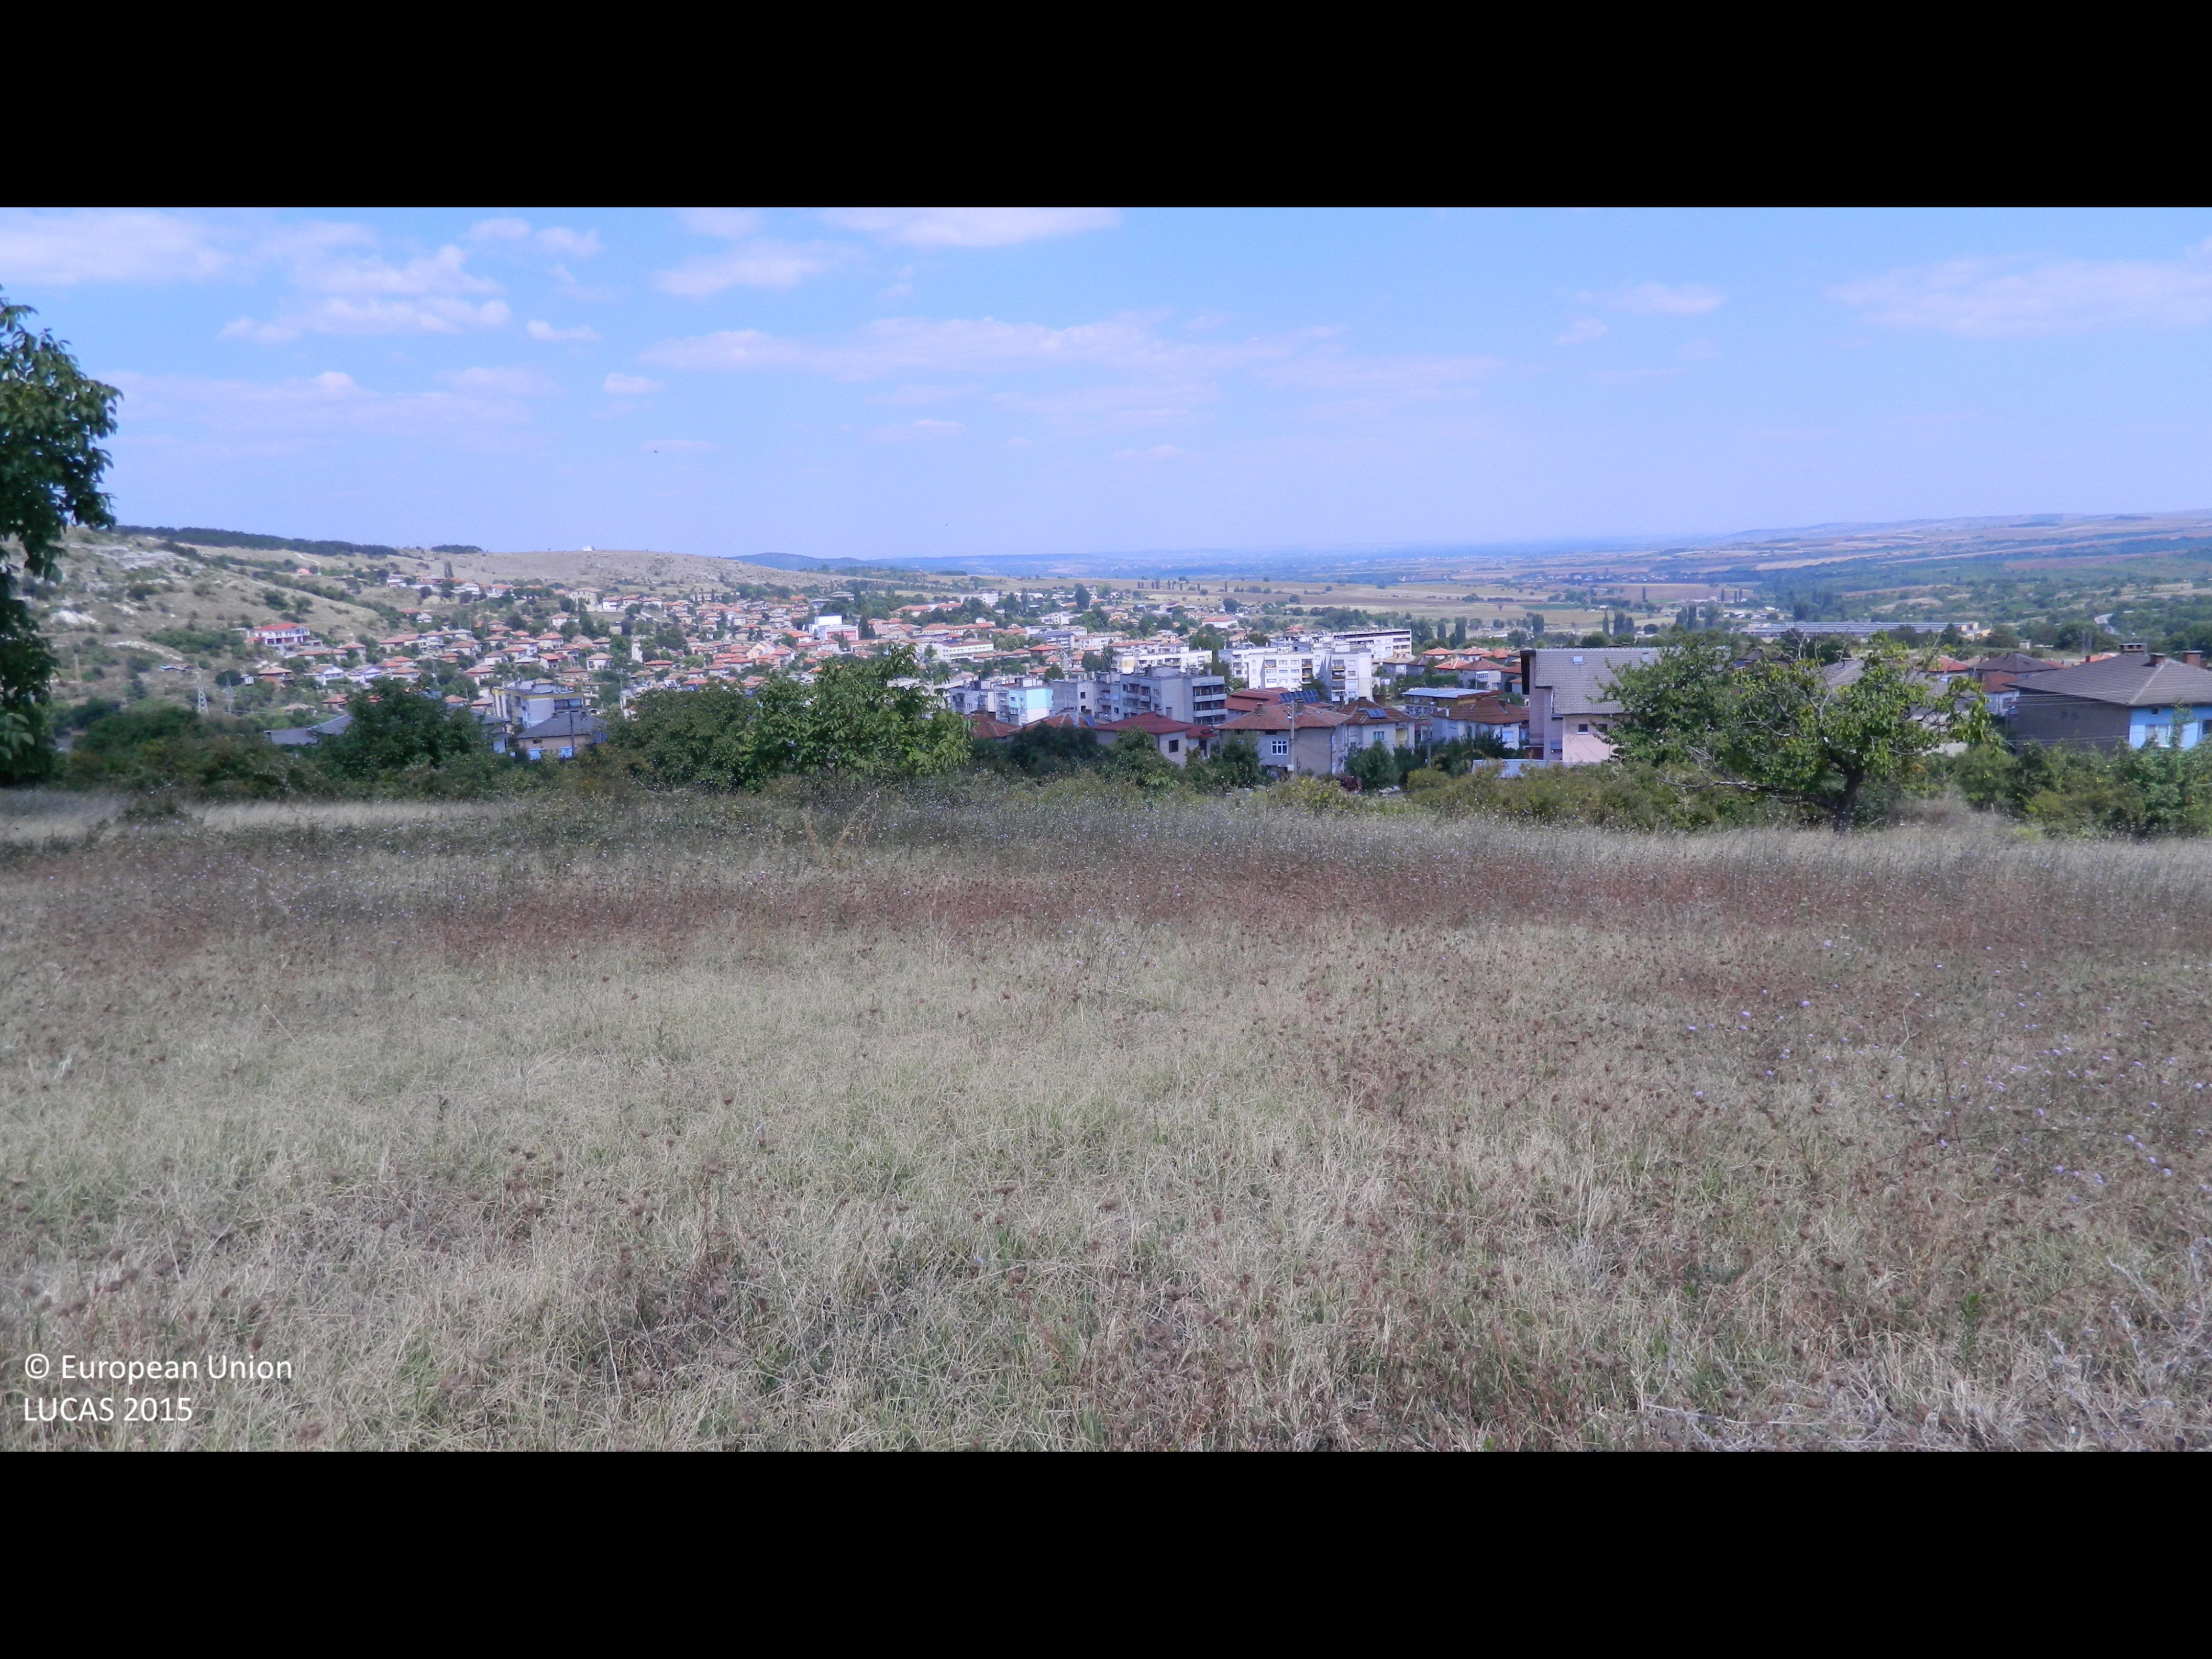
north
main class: Grassland
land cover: Grassland without tree/shrub cover
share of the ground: > 75 %
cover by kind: herbaceous plants 95 %, shrubs 5 %
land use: Agriculture (excluding fallow land and kitchen gardens)
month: August
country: BG
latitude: 41.5190
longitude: 26.1157
